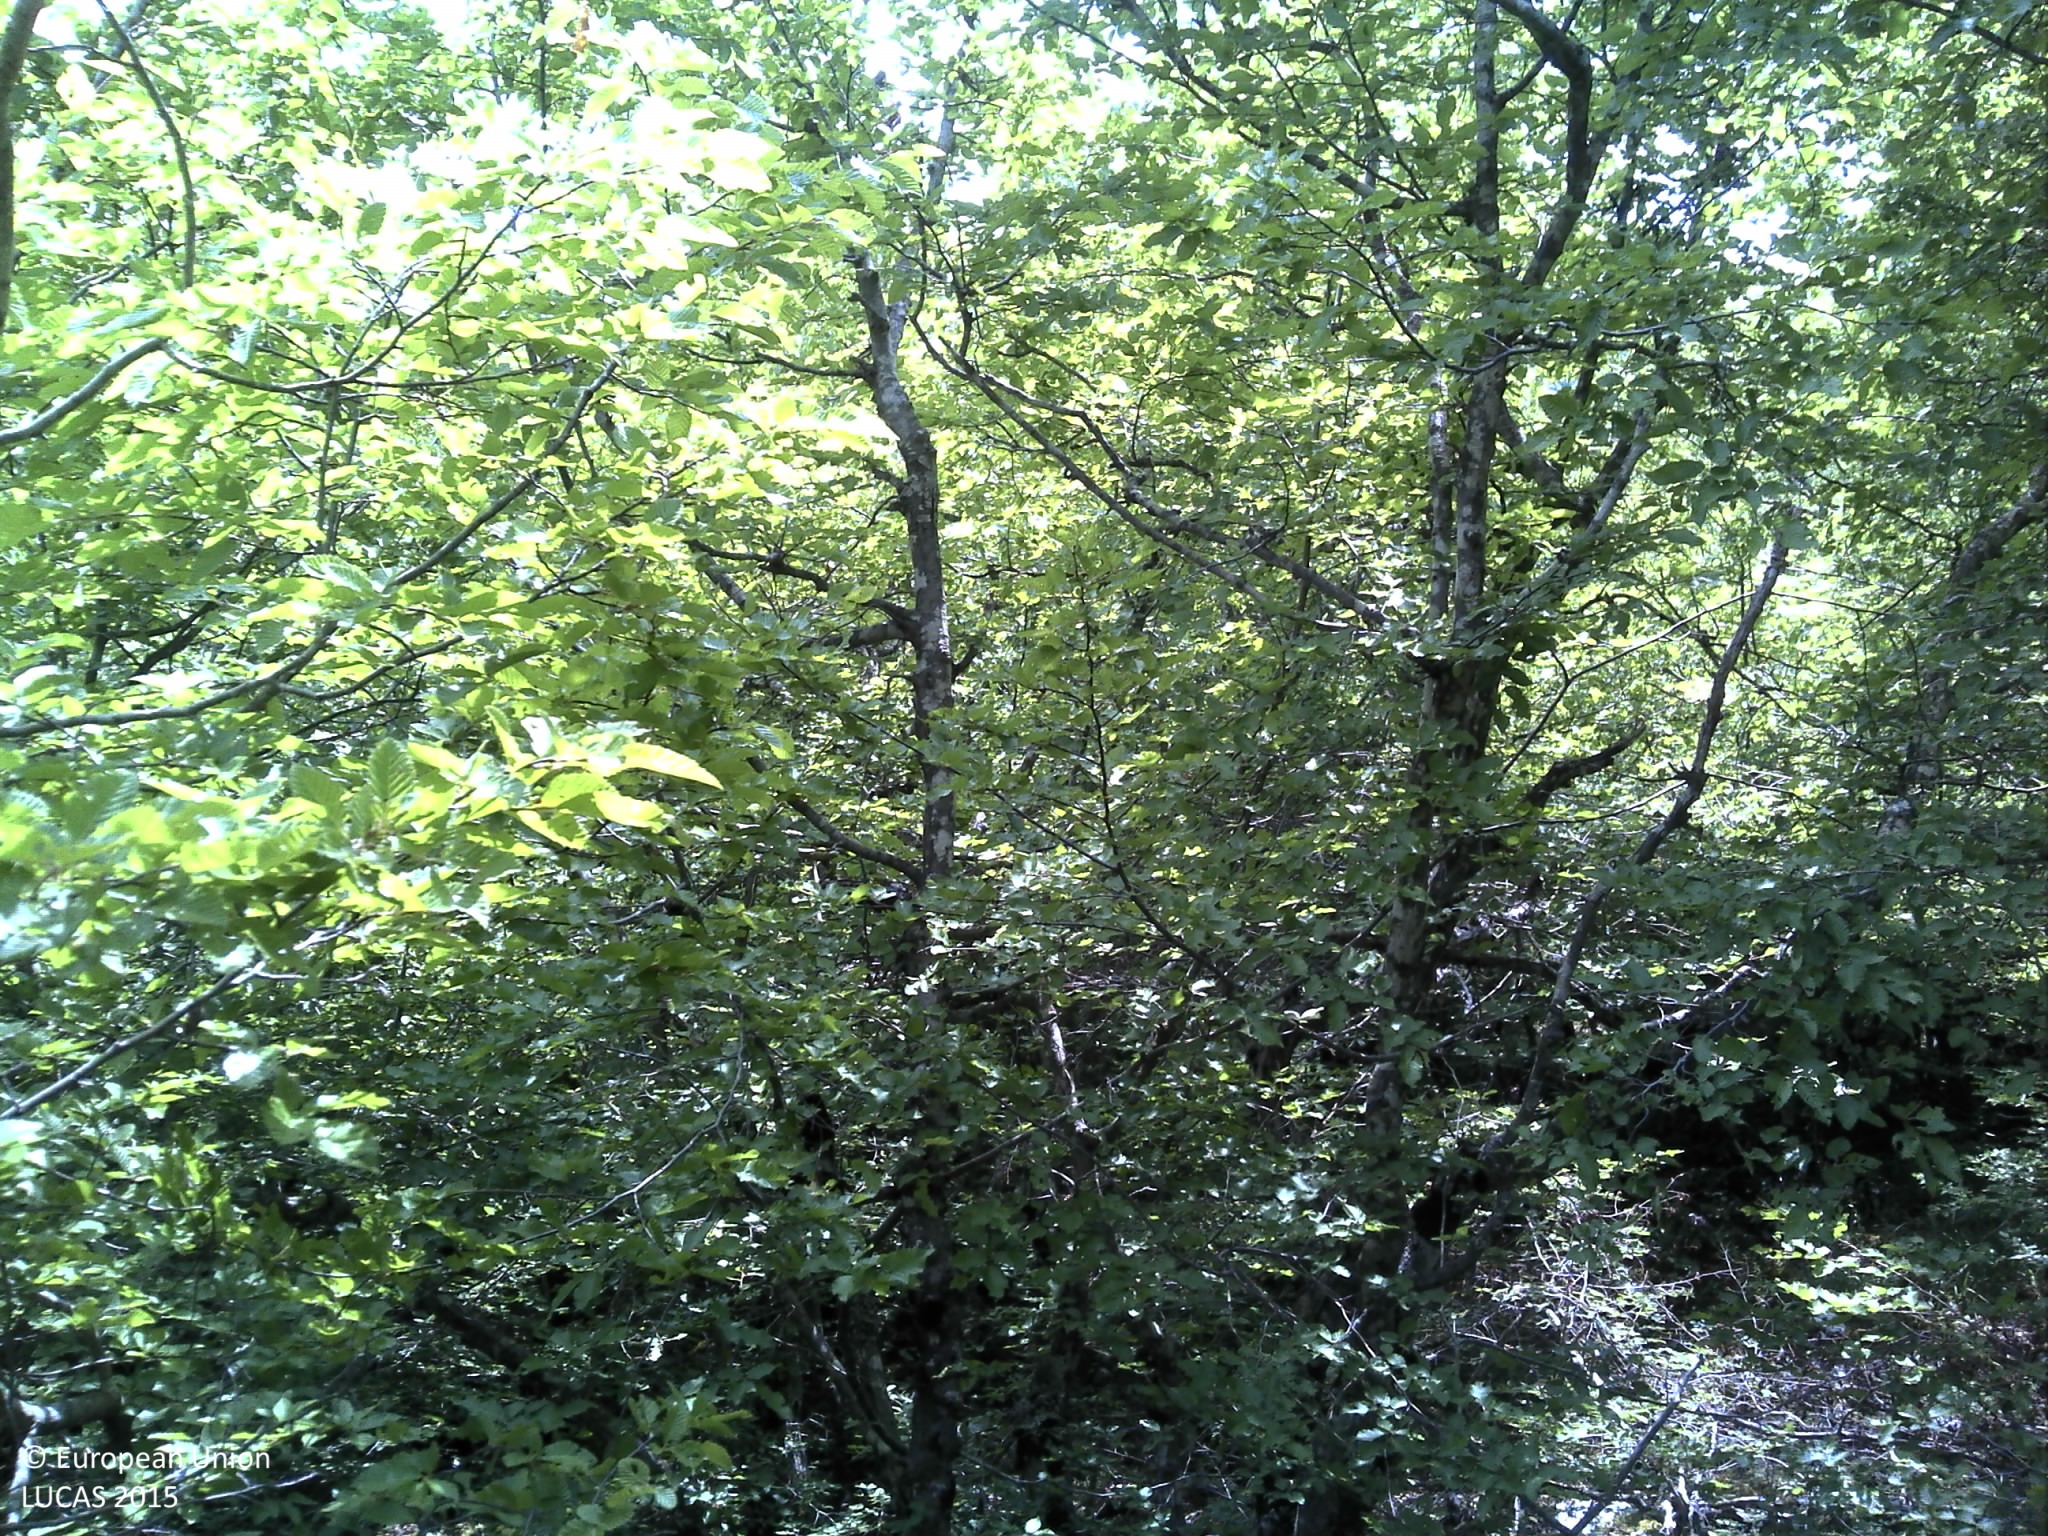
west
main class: Woodland
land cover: Broadleaved woodland
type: beech forest
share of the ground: 50 - 75 %
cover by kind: broadleaved forest trees 65 %, shrubs 25 %, consolidated bare surface 10 %
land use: Semi-natural and natural areas not in use
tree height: > 5 m
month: June
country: HR
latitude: 44.4071
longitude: 16.0839
